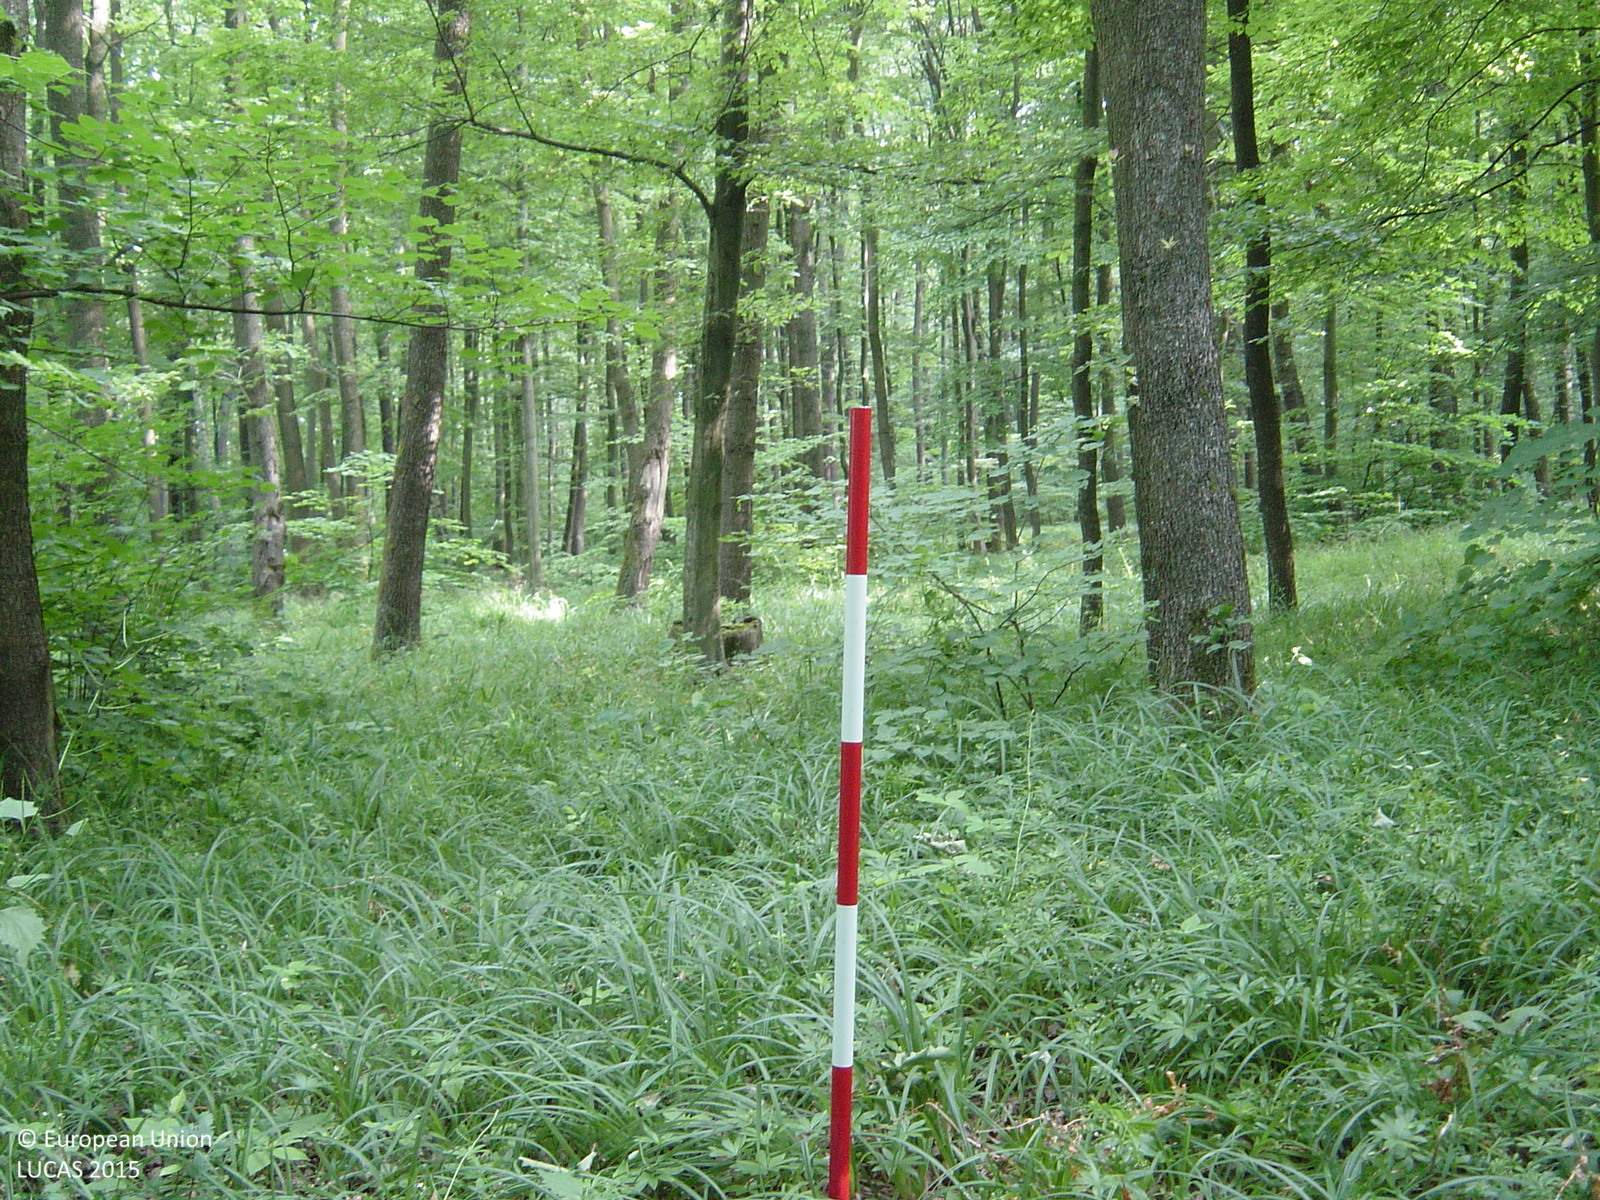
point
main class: Woodland
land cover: Broadleaved woodland
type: mesophytic deciduous forest
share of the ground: > 75 %
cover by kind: broadleaved forest trees 85 %, herbaceous plants 15 %
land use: Forestry
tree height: > 5 m
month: June
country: CZ
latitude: 49.2238
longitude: 17.0808
